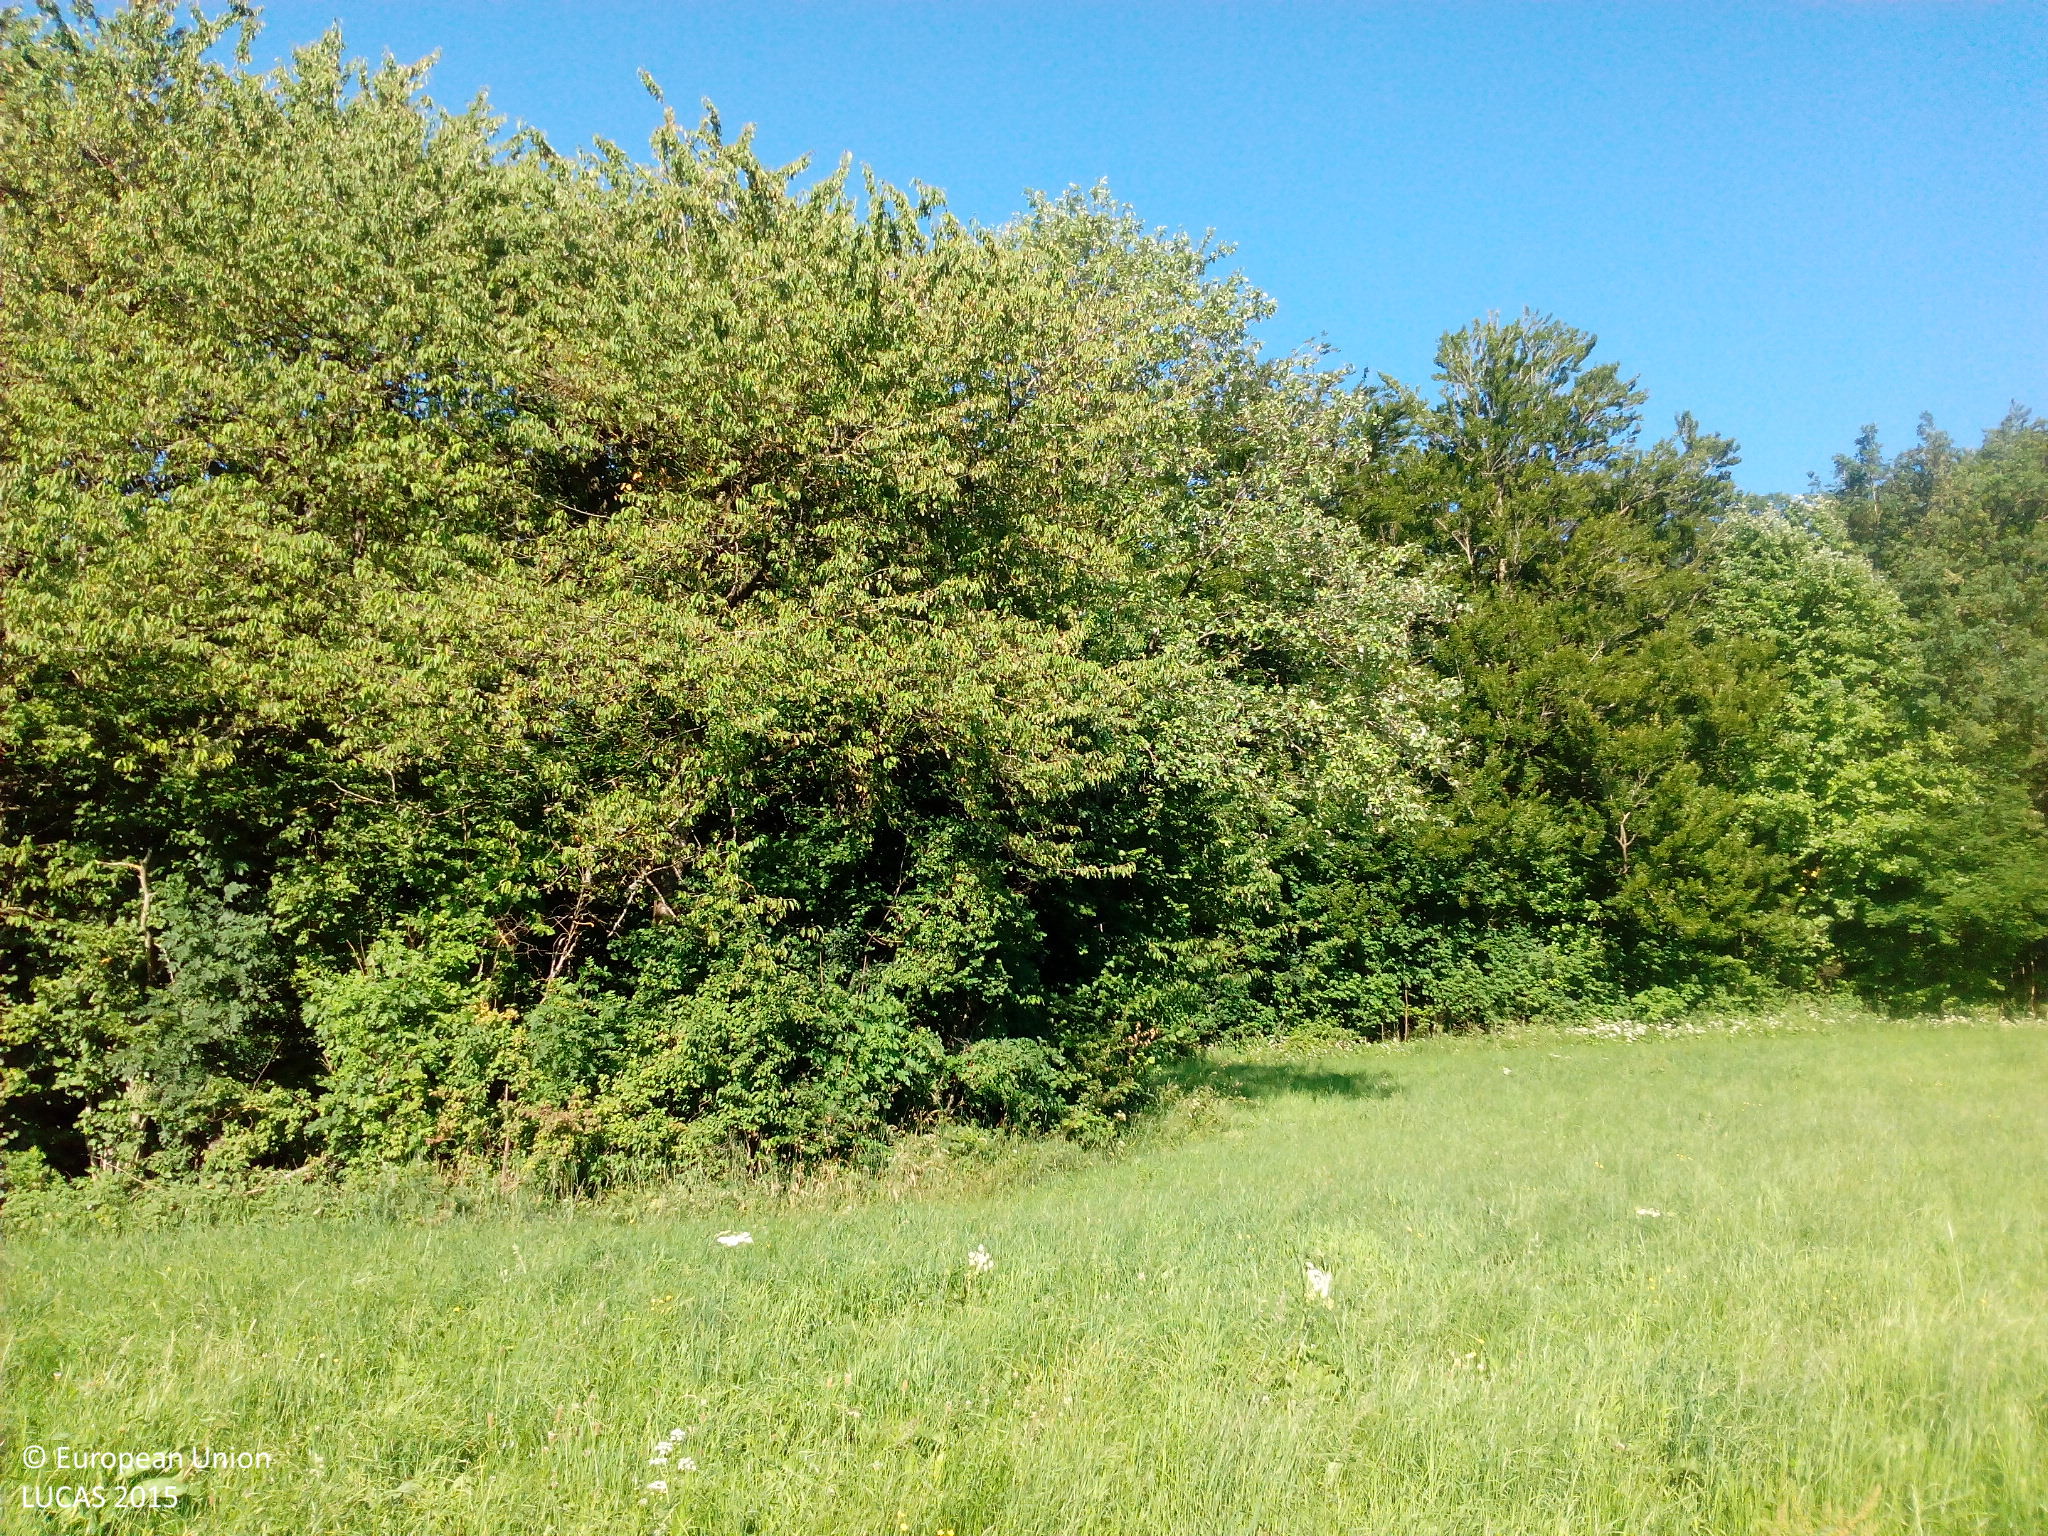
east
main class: Grassland
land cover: Grassland without tree/shrub cover
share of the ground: > 75 %
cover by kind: herbaceous plants 100 %
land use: Agriculture (excluding fallow land and kitchen gardens)
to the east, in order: Grassland without tree/shrub cover; Broadleaved woodland; Grassland without tree/shrub cover; Broadleaved woodland; Rock outcrops; Broadleaved woodland; Rock outcrops; Broadleaved woodland; Shrubland with sparse tree cover; Fences; Tracks; Nurseries
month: July
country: DE
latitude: 48.3295
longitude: 9.3394
